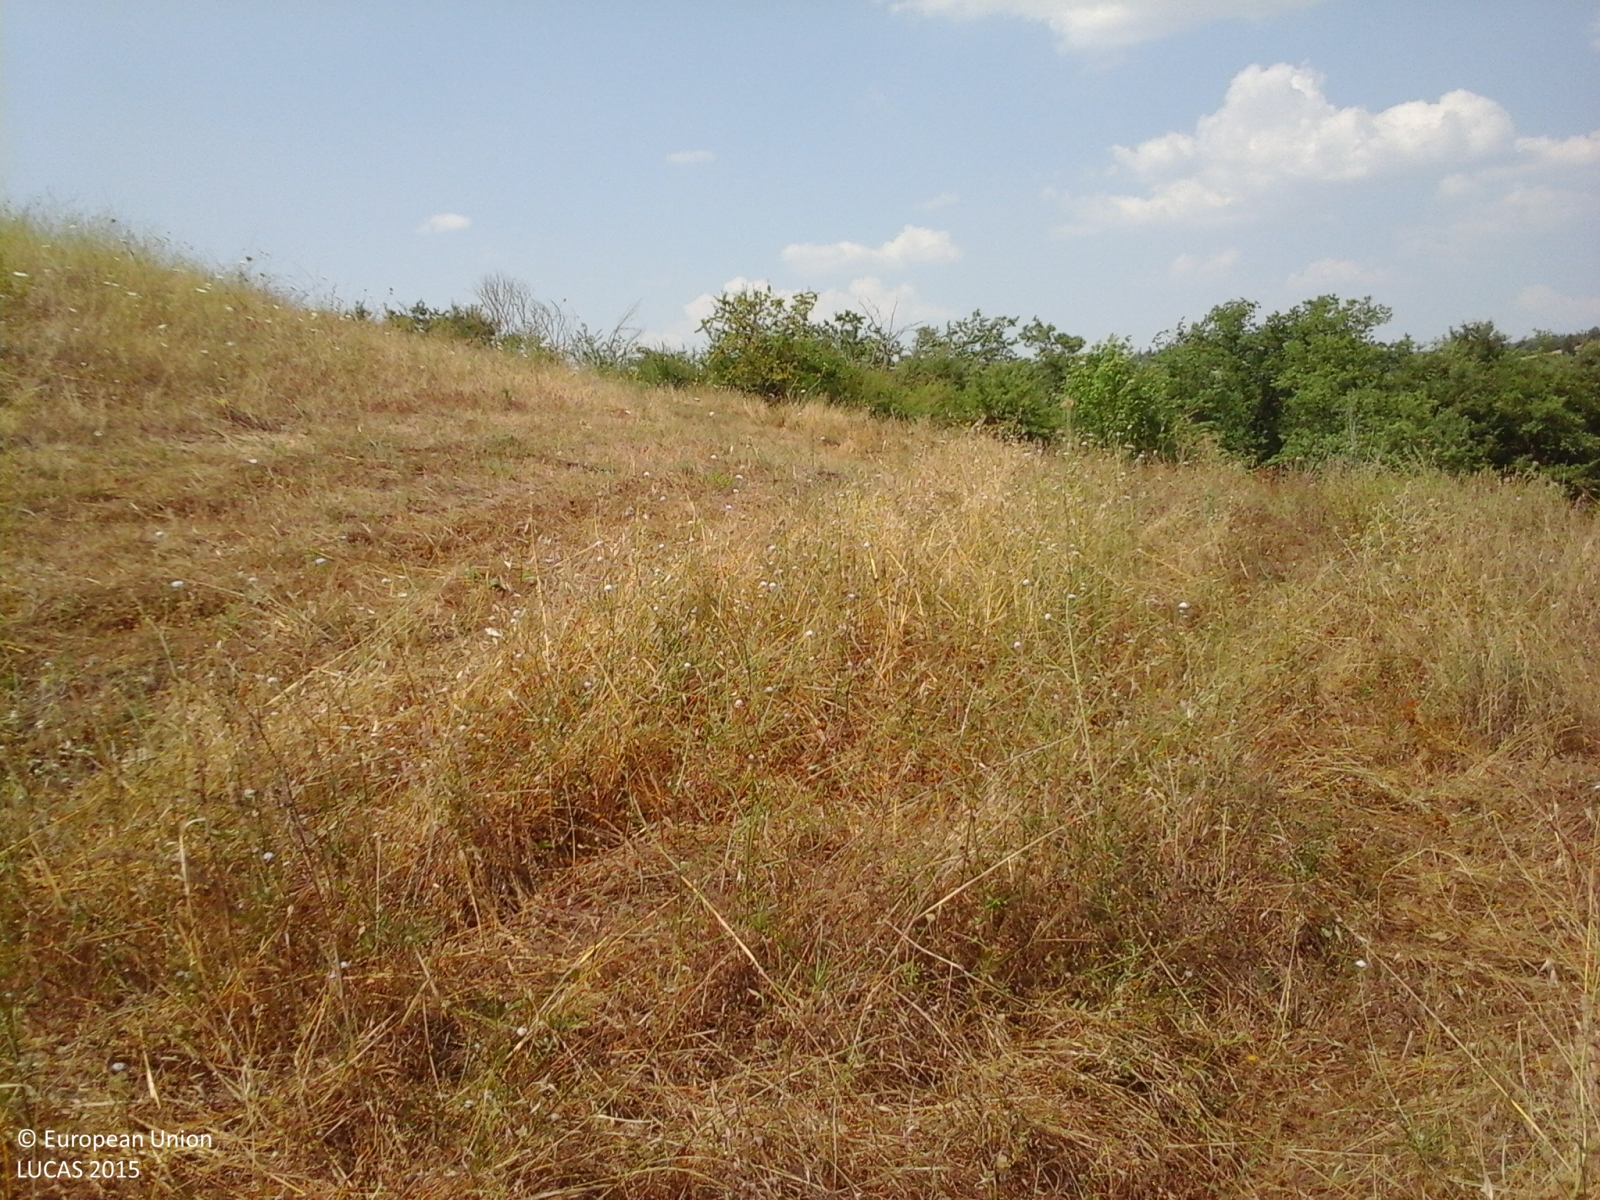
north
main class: Woodland
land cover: Broadleaved woodland
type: thermophilous deciduous forest
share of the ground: > 75 %
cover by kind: broadleaved forest trees 75 %, shrubs 20 %, herbaceous plants 5 %
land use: Semi-natural and natural areas not in use
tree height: > 5 m
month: July
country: IT
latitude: 43.1297
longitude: 11.5565
